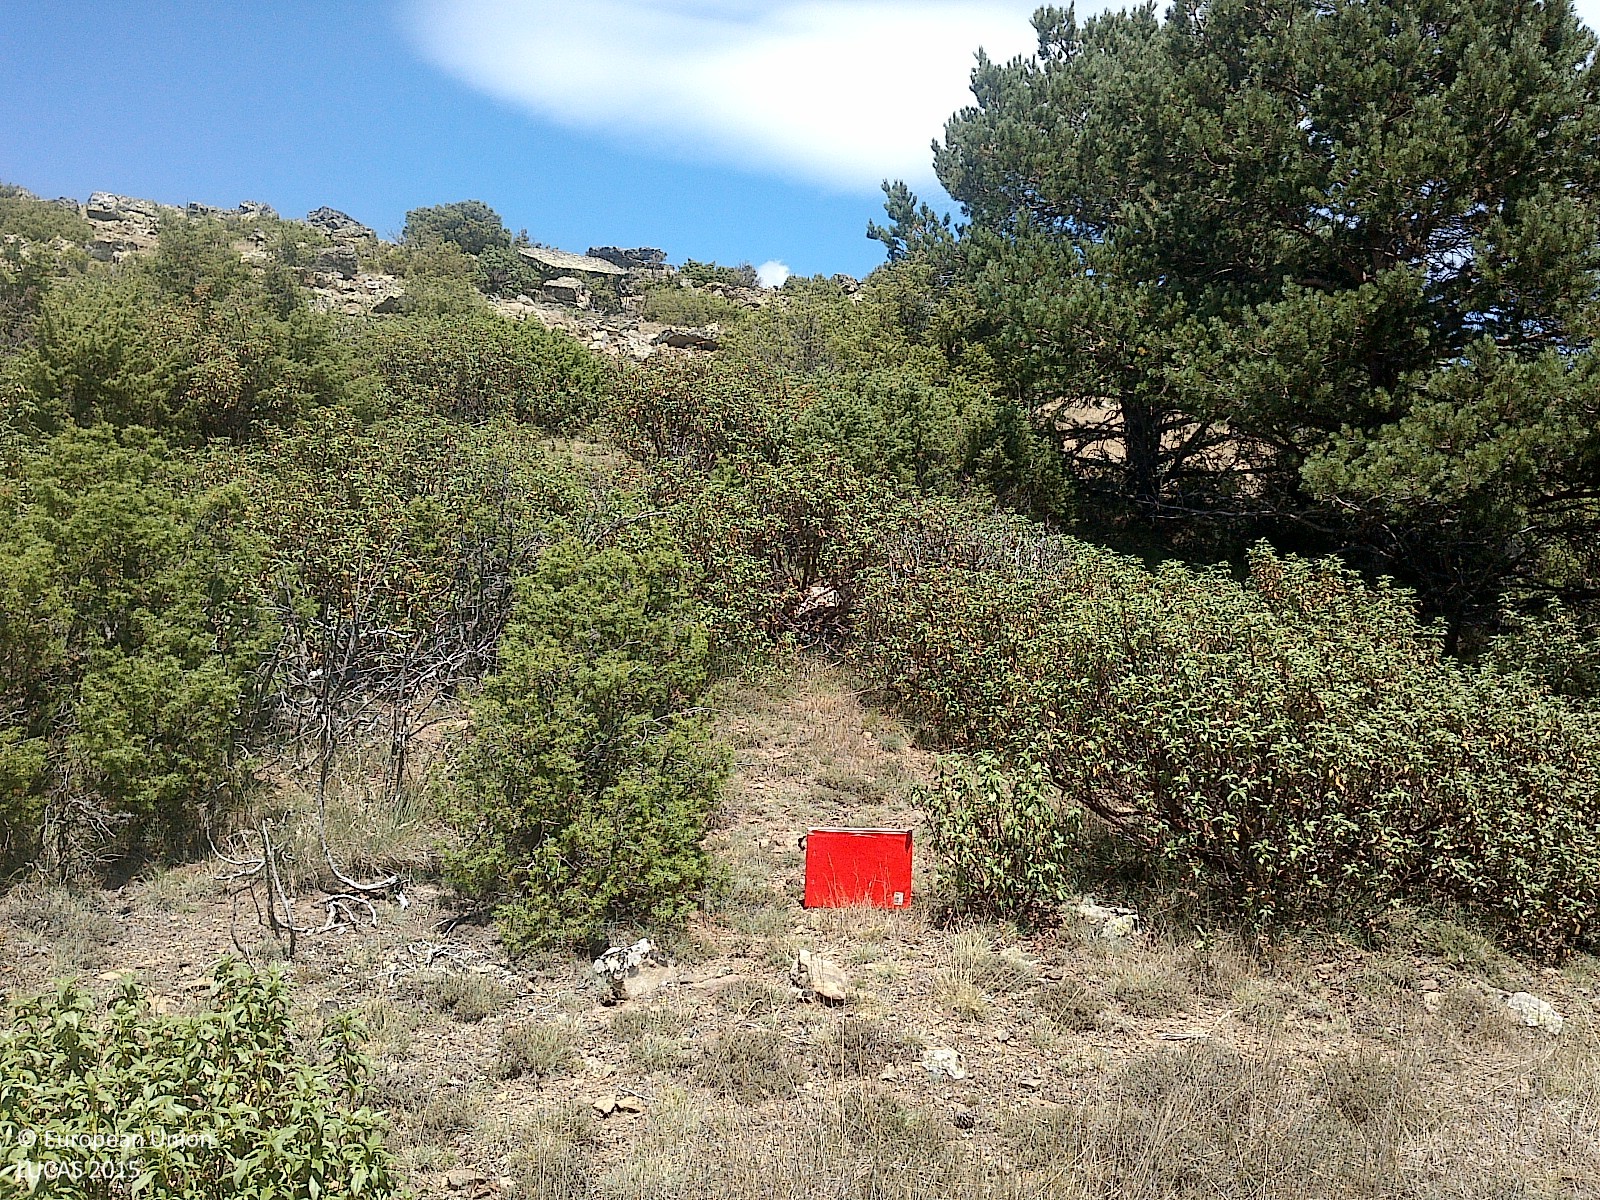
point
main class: Woodland
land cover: Pine dominated coniferous woodland
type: coniferous forest of the mediterranean region
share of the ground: 10 - 25 %
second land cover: Grassland without tree/shrub cover
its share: 25 - 50 %
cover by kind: herbaceous plants 40 %, shrubs 25 %, coniferous forest trees 20 %, unconsolidated bare surface 10 %, consolidated bare surface 5 %
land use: Forestry
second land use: Agriculture (excluding fallow land and kitchen gardens)
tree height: < 5 m
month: July
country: ES
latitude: 41.9962
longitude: -2.1206
